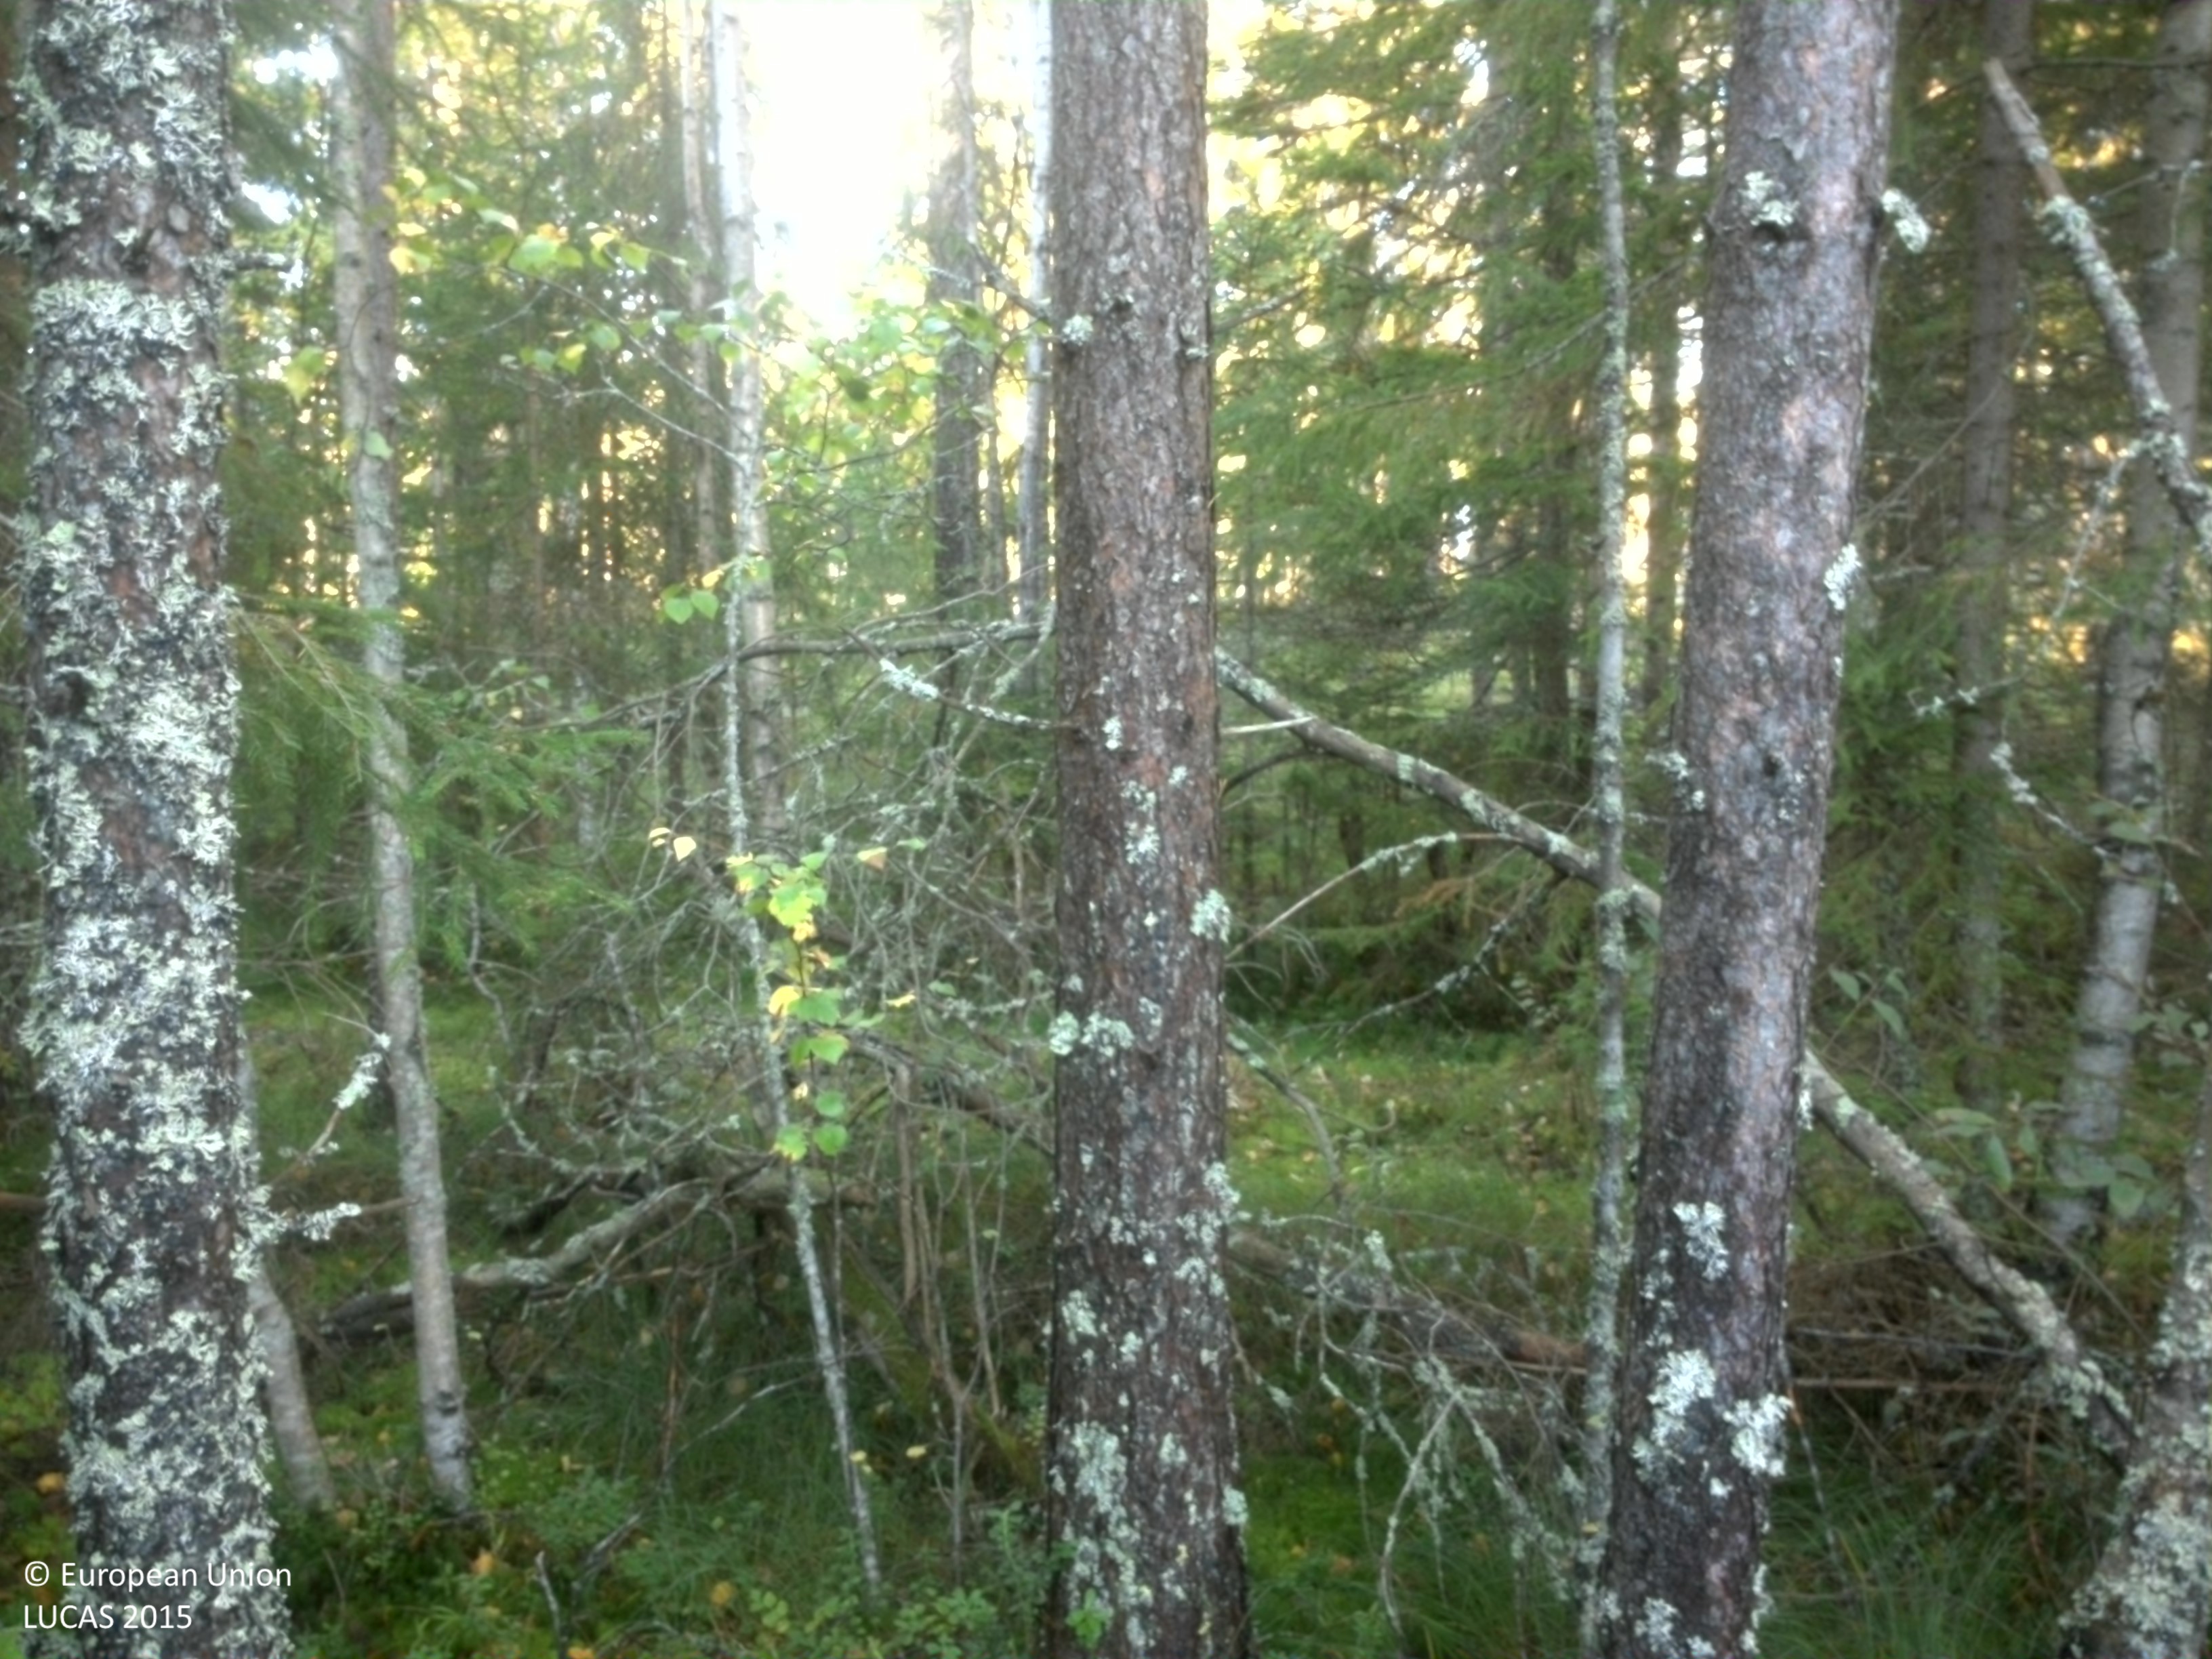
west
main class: Woodland
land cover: Pine dominated mixed woodland
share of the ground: > 75 %
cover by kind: coniferous forest trees 50 %, broadleaved forest trees 25 %, shrubs 10 %, lichens and mosses 10 %, herbaceous plants 5 %
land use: Forestry
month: September
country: SE
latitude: 59.9007
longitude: 15.2991
